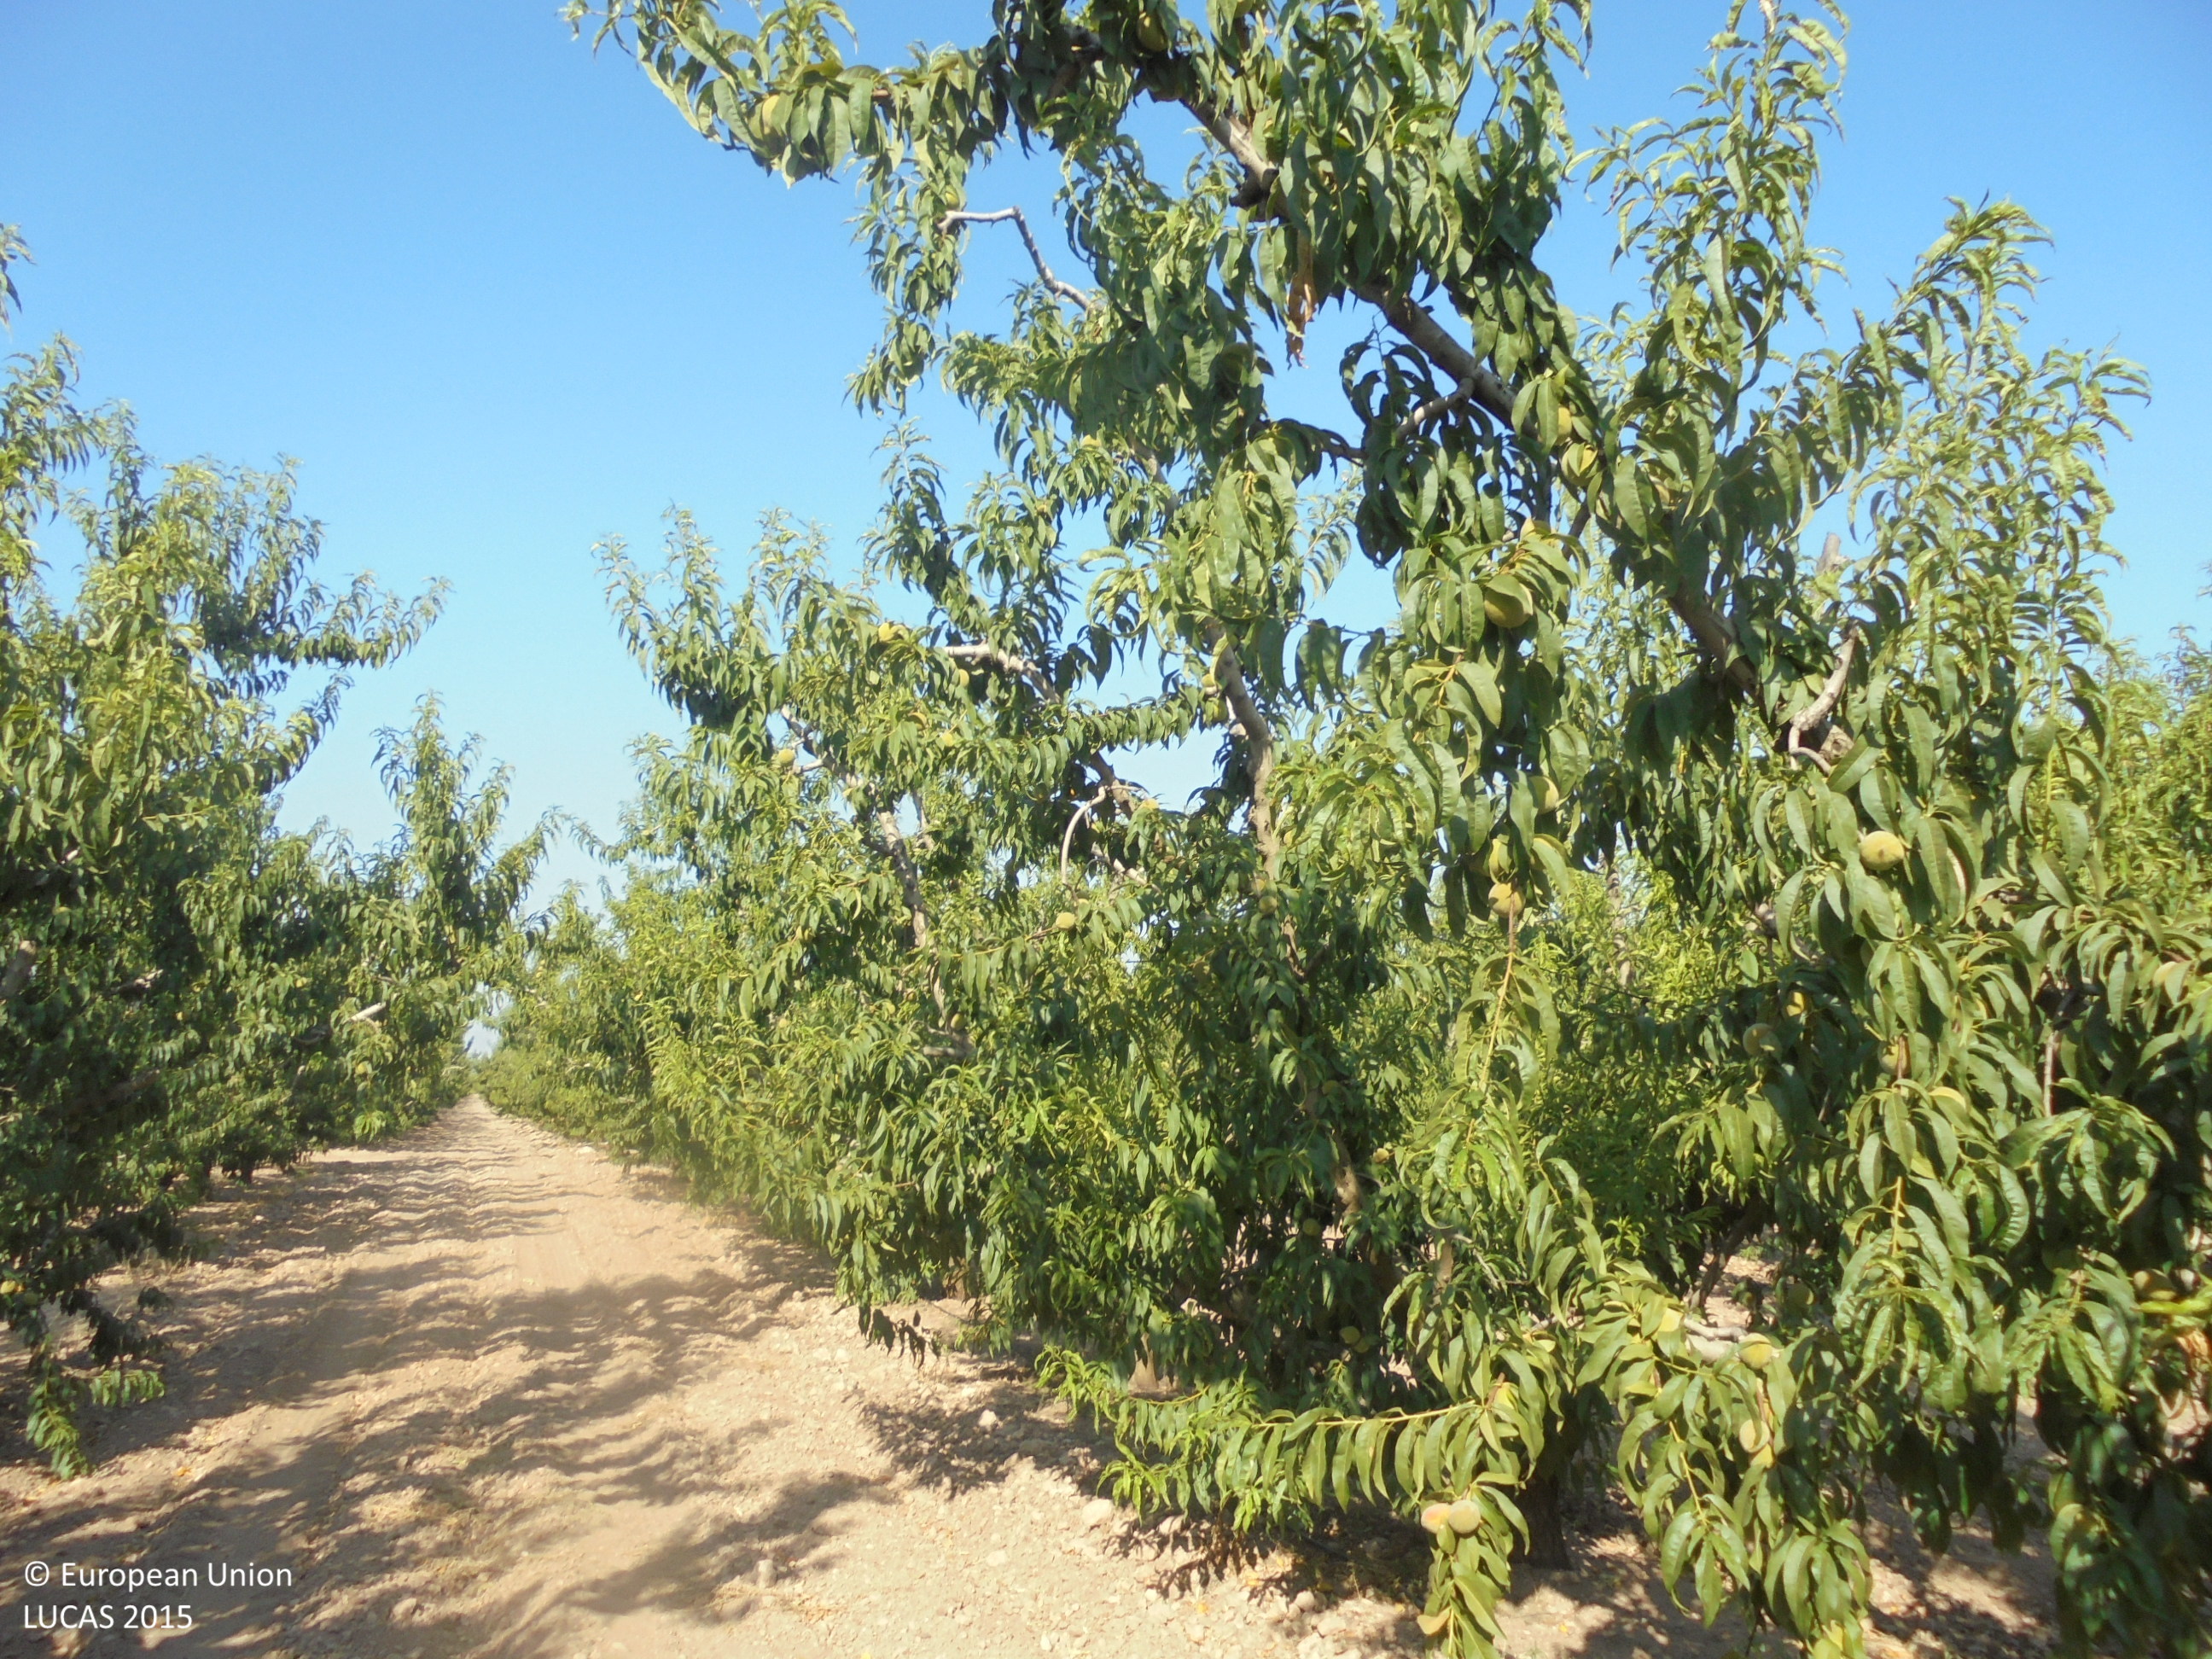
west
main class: Cropland
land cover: Other fruit trees and berries
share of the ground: > 75 %
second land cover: Other bare soil
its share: > 75 %
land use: Agriculture (excluding fallow land and kitchen gardens)
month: July
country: ES
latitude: 38.5500
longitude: -1.4783
